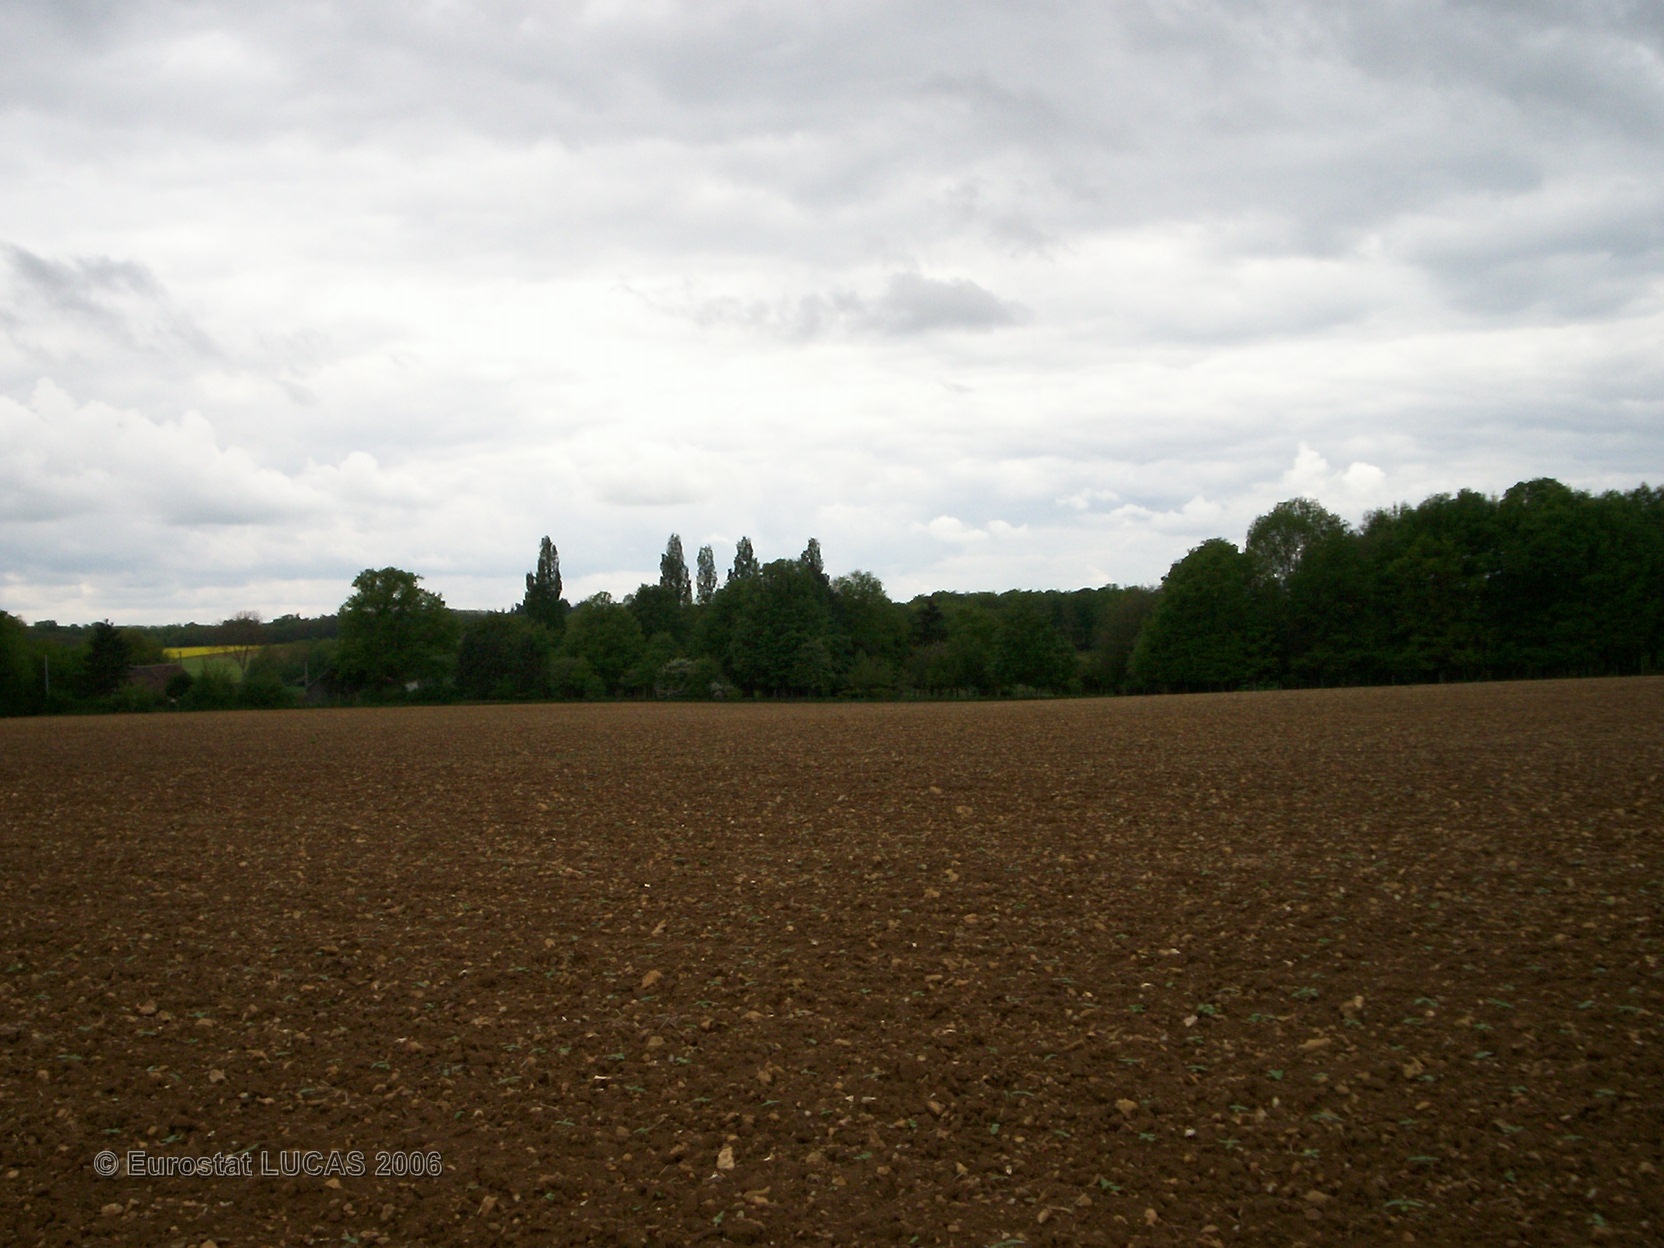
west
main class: Cropland
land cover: Sunflower
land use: Agriculture (excluding fallow land and kitchen gardens)
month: May
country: FR
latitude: 48.0178
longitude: 2.9809
